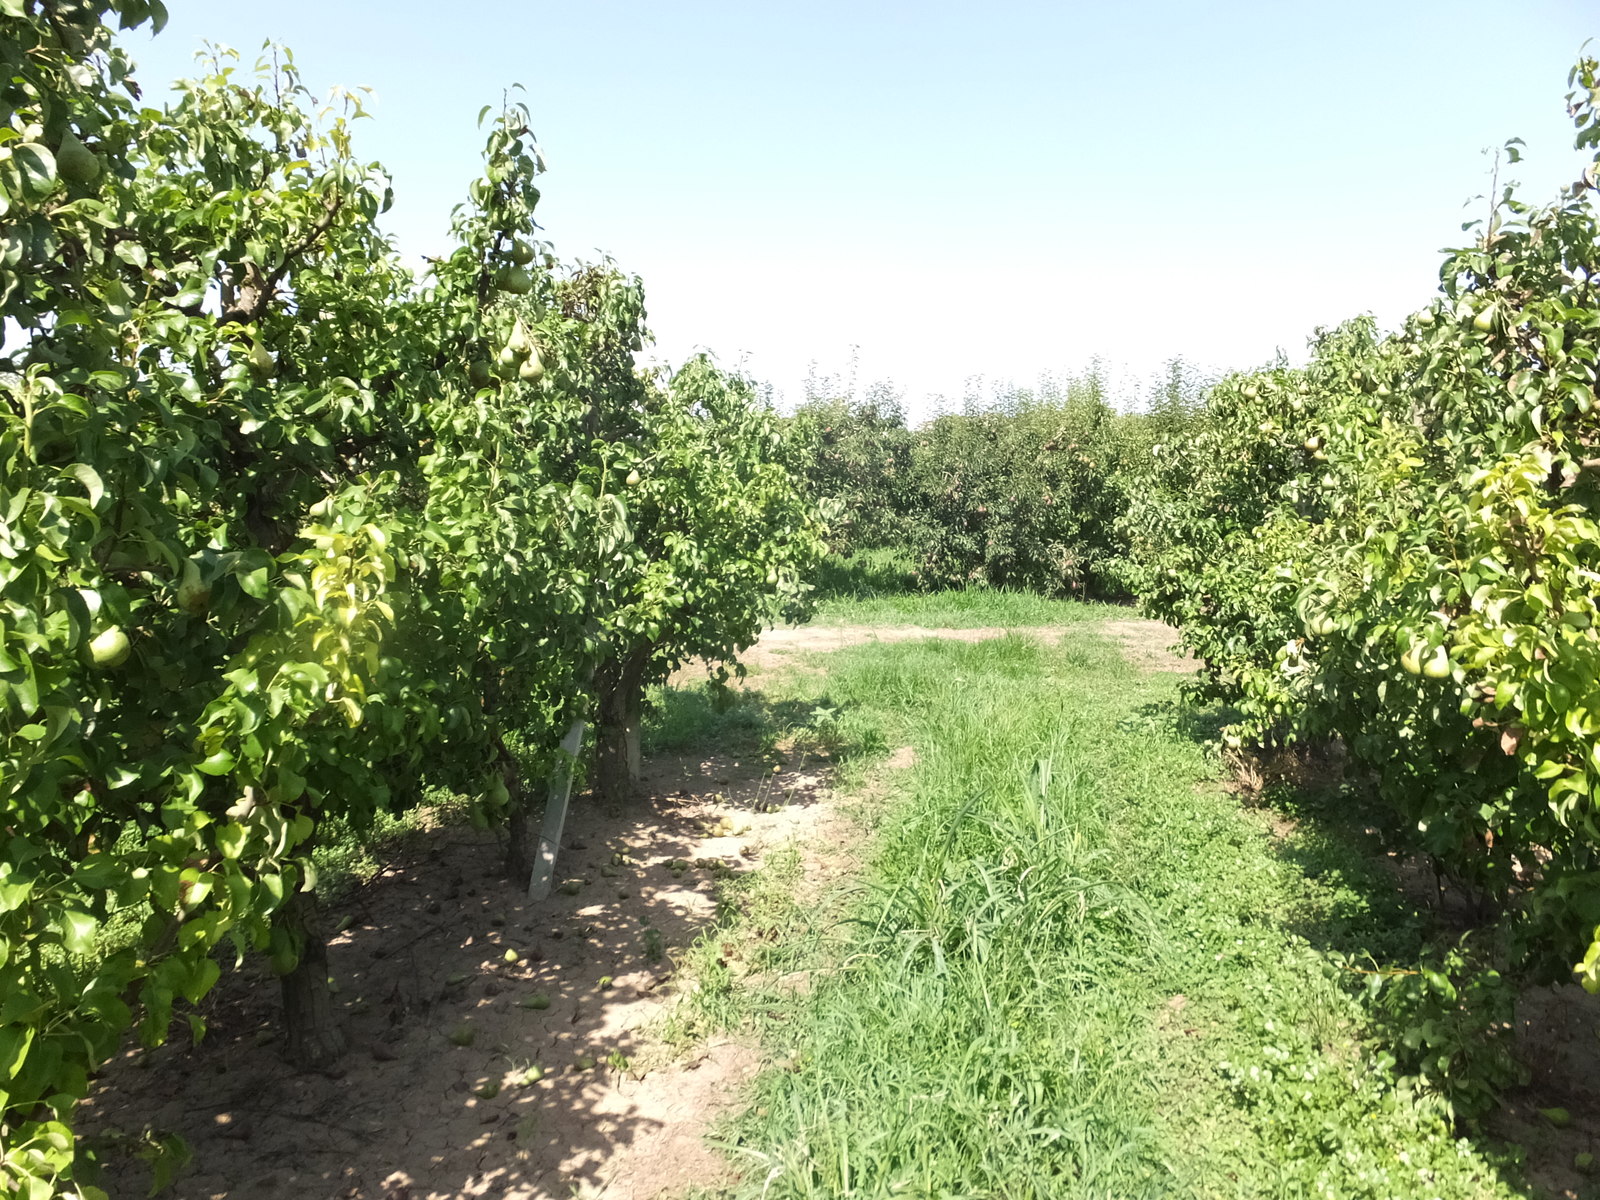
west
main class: Cropland
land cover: Pear fruit
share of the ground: > 75 %
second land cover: Spontaneously vegetated surfaces
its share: 25 - 50 %
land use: Agriculture (excluding fallow land and kitchen gardens)
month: July
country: ES
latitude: 41.4943
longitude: 0.4651
